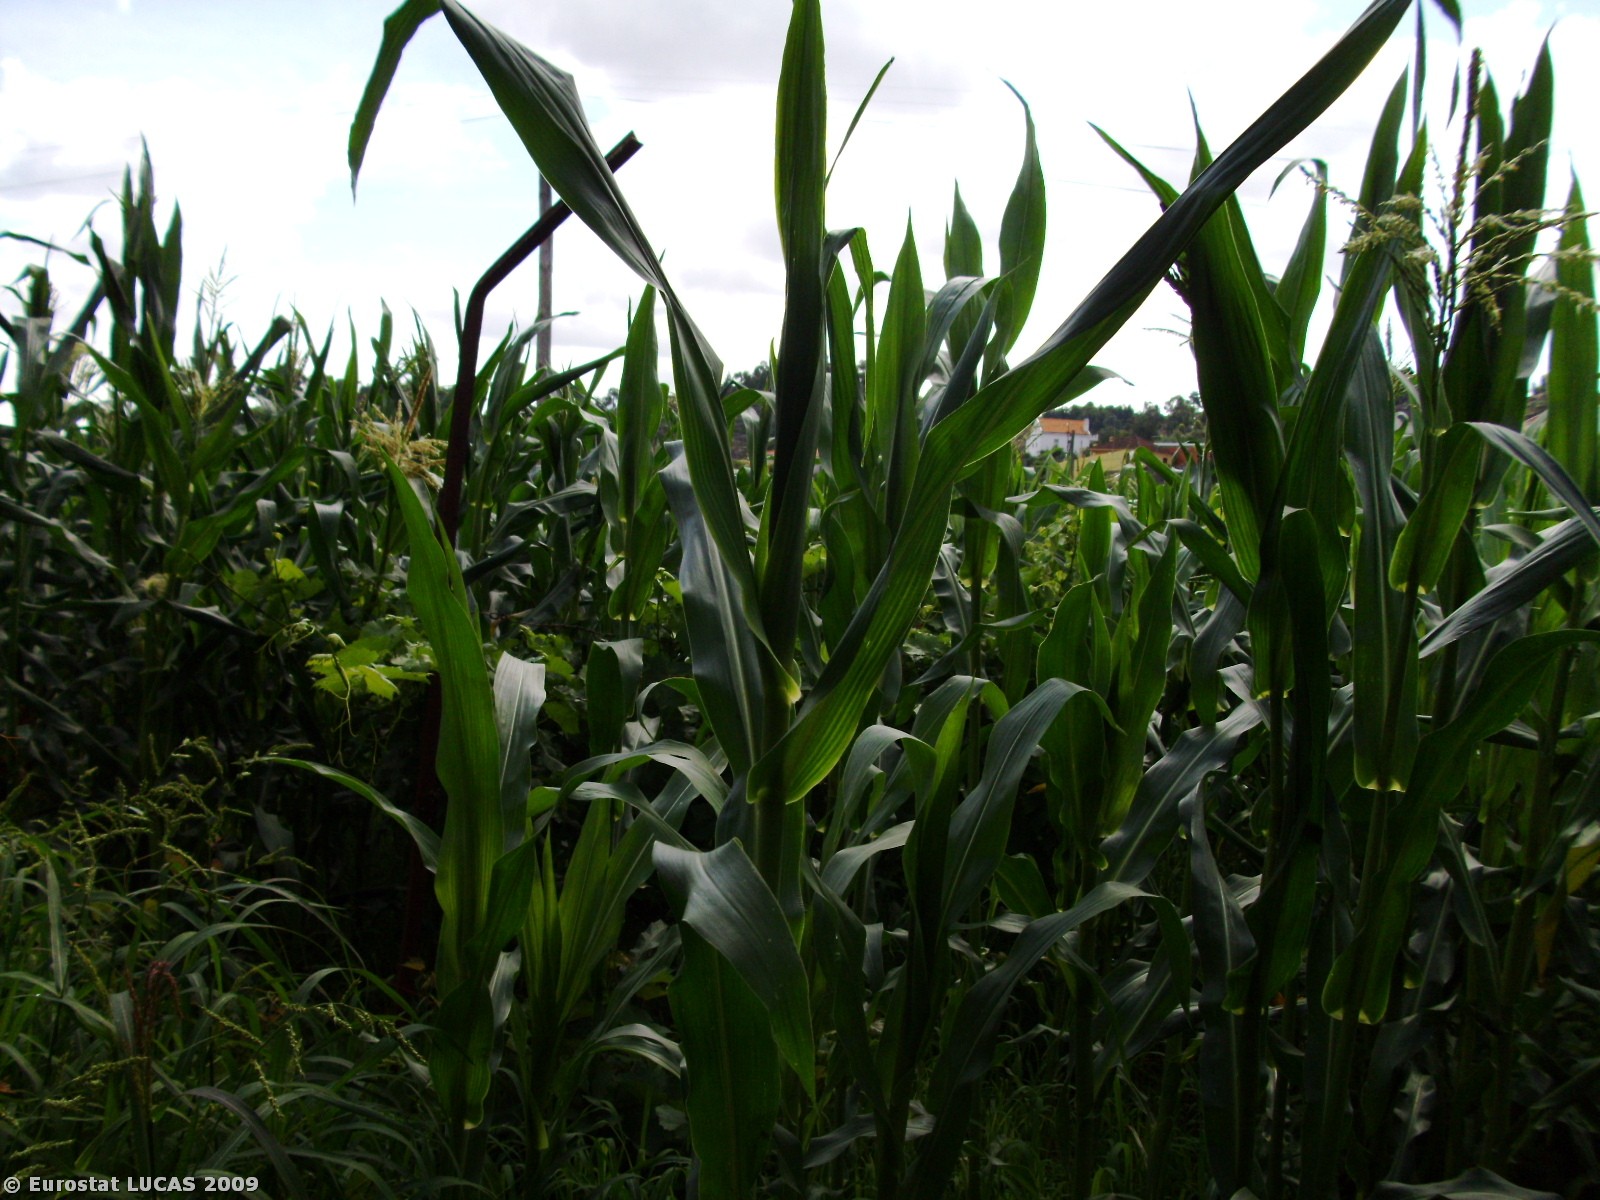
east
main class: Cropland
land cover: Maize
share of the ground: > 75 %
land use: Agriculture (excluding fallow land and kitchen gardens)
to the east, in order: Maize; Electric lines; Maize; Dry stone walls; Other non-permanent industrial crops; Fences; Bare land; Other fresh vegetables; Potatoes; Fences; Paved roads, cycling and walking lanes; Dry stone walls; Electric lines; Potatoes; Spontaneously vegetated surfaces; Dry stone walls; Spontaneously vegetated surfaces; Dry stone walls; Spontaneously vegetated surfaces; Dry stone walls; Other fresh vegetables; Artificial constructions in urban areas; Maize; Dry stone walls; Fences; Artificial constructions in urban areas
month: July
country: PT
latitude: 40.5406
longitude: -7.6244
